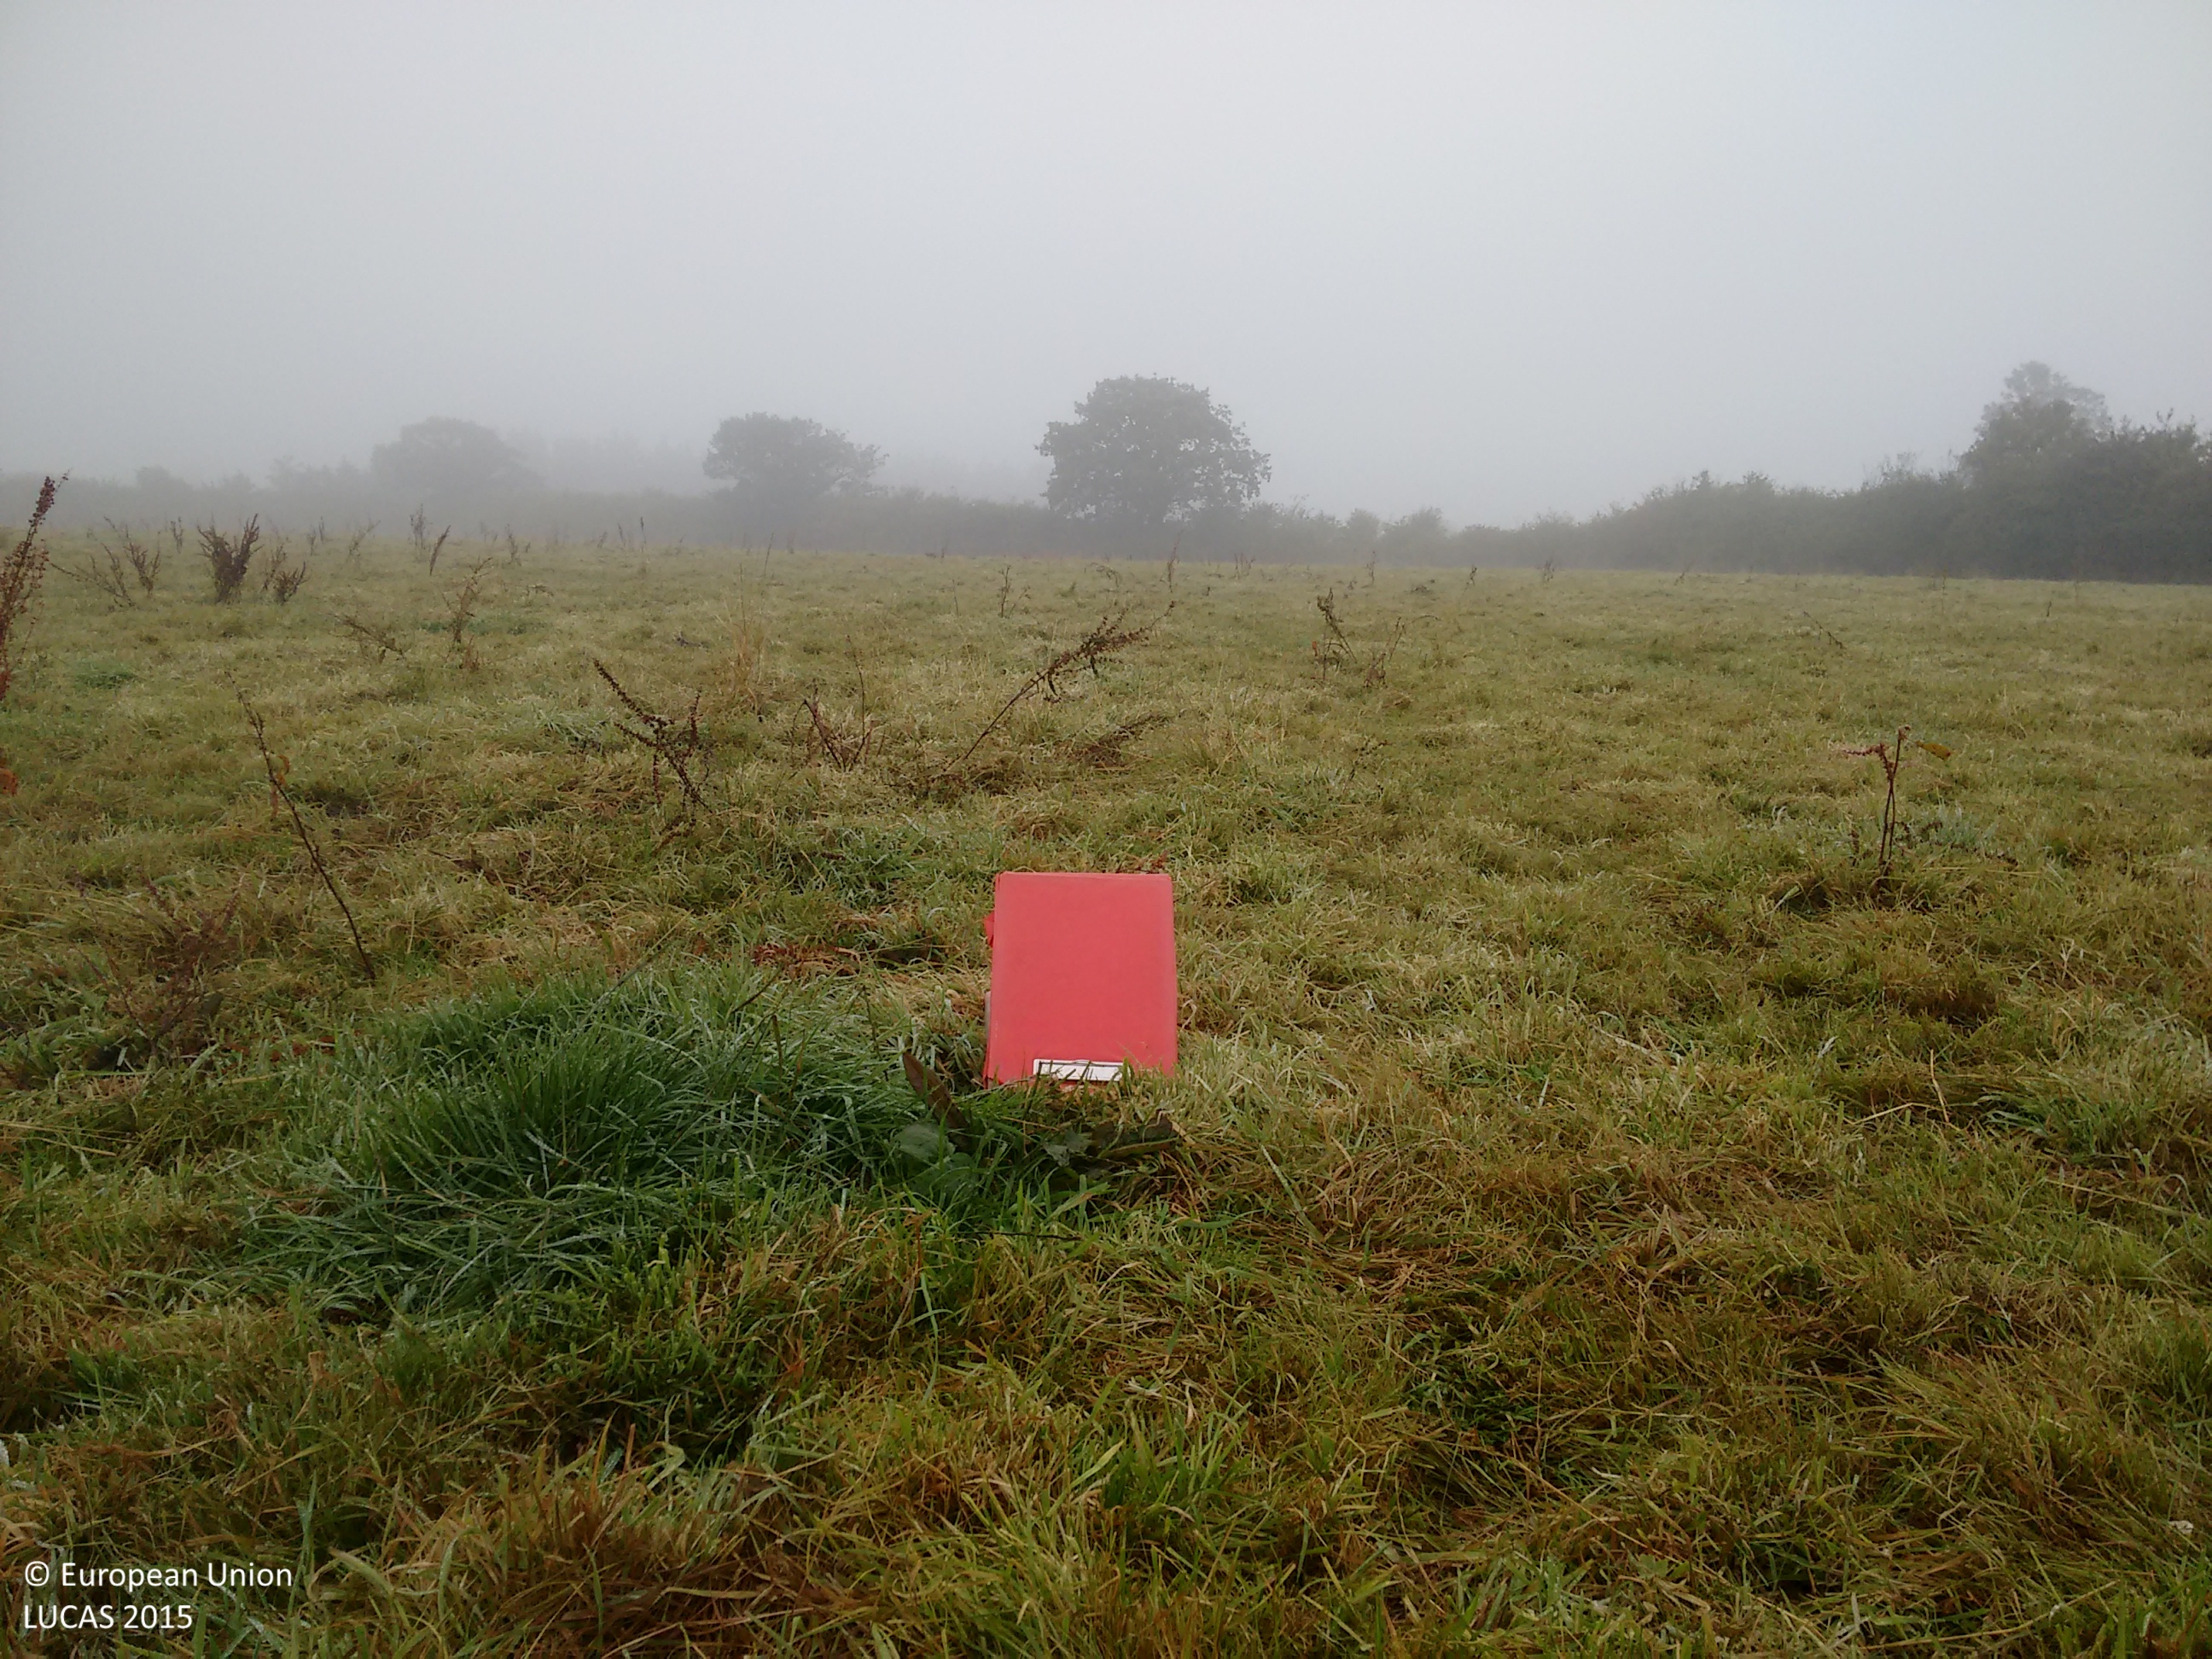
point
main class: Grassland
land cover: Grassland without tree/shrub cover
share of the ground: > 75 %
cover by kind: herbaceous plants 100 %
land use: Agriculture (excluding fallow land and kitchen gardens)
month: October
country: IE
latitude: 52.4448
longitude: -9.0314
